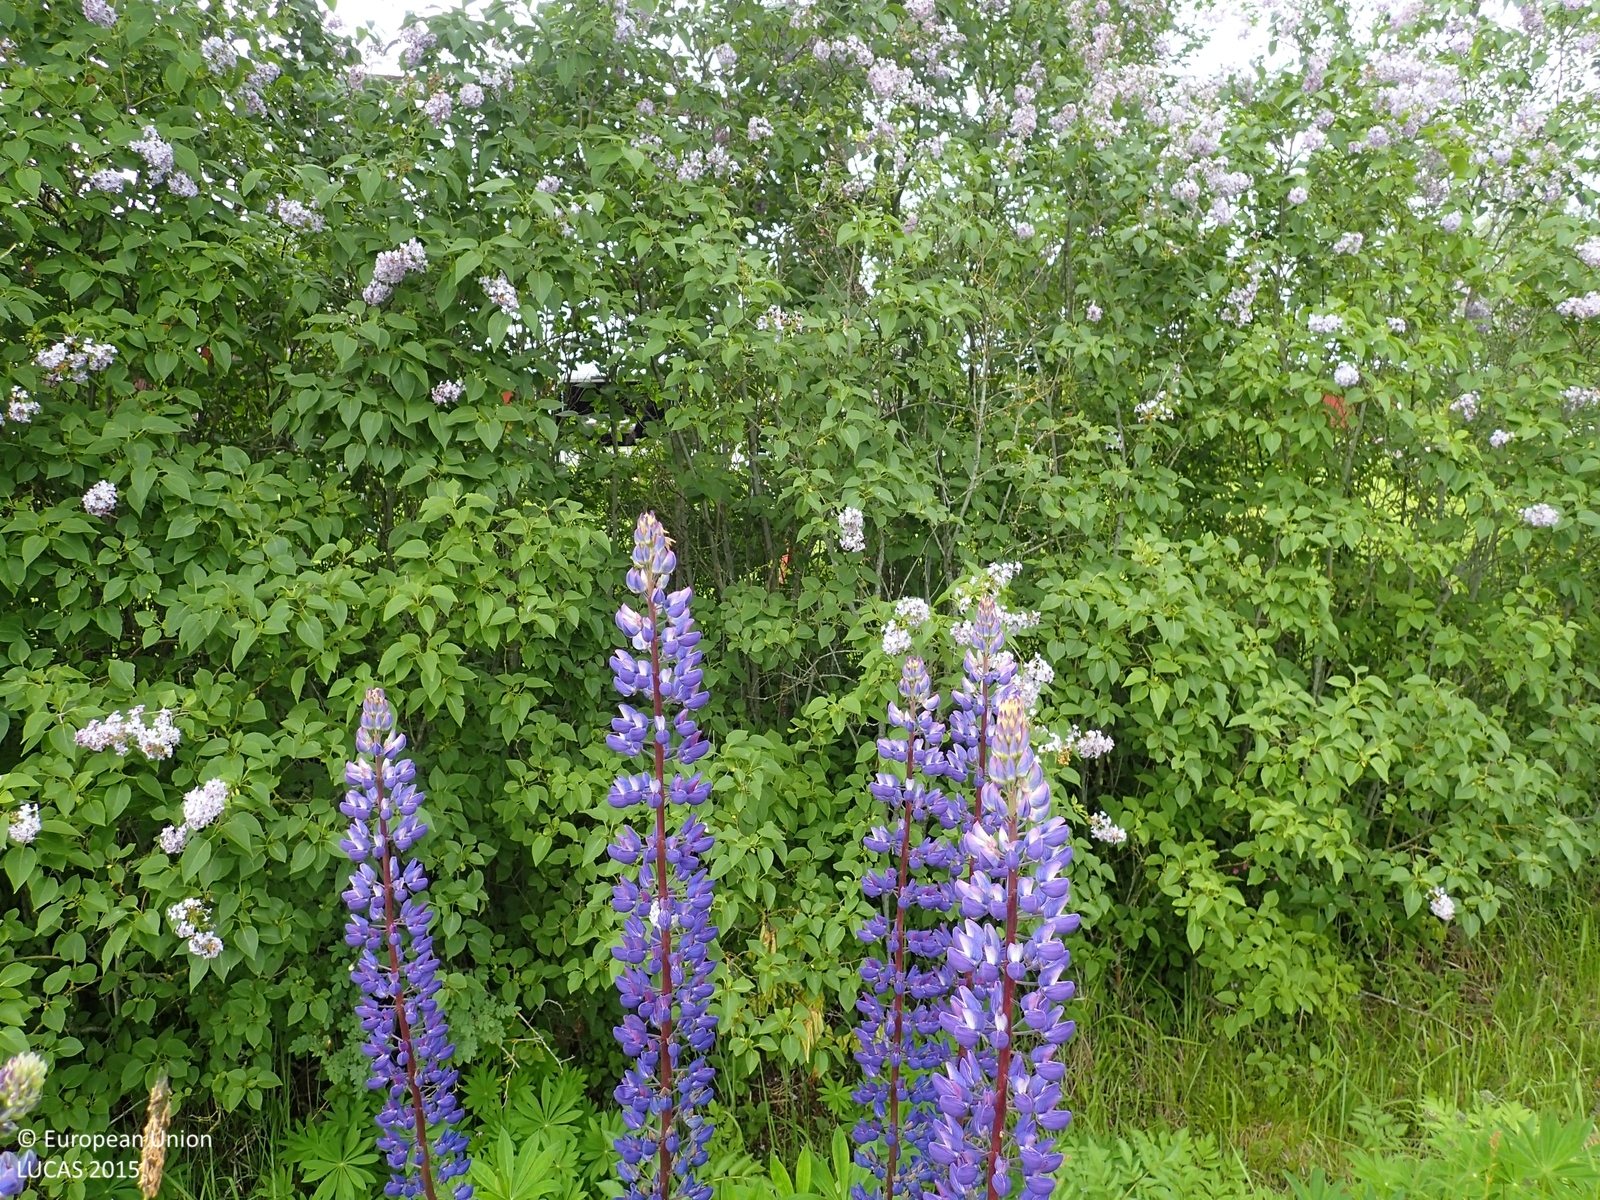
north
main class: Grassland
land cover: Grassland without tree/shrub cover
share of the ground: > 75 %
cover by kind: herbaceous plants 100 %
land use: Residential
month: June
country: FI
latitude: 62.5391
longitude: 21.4526
